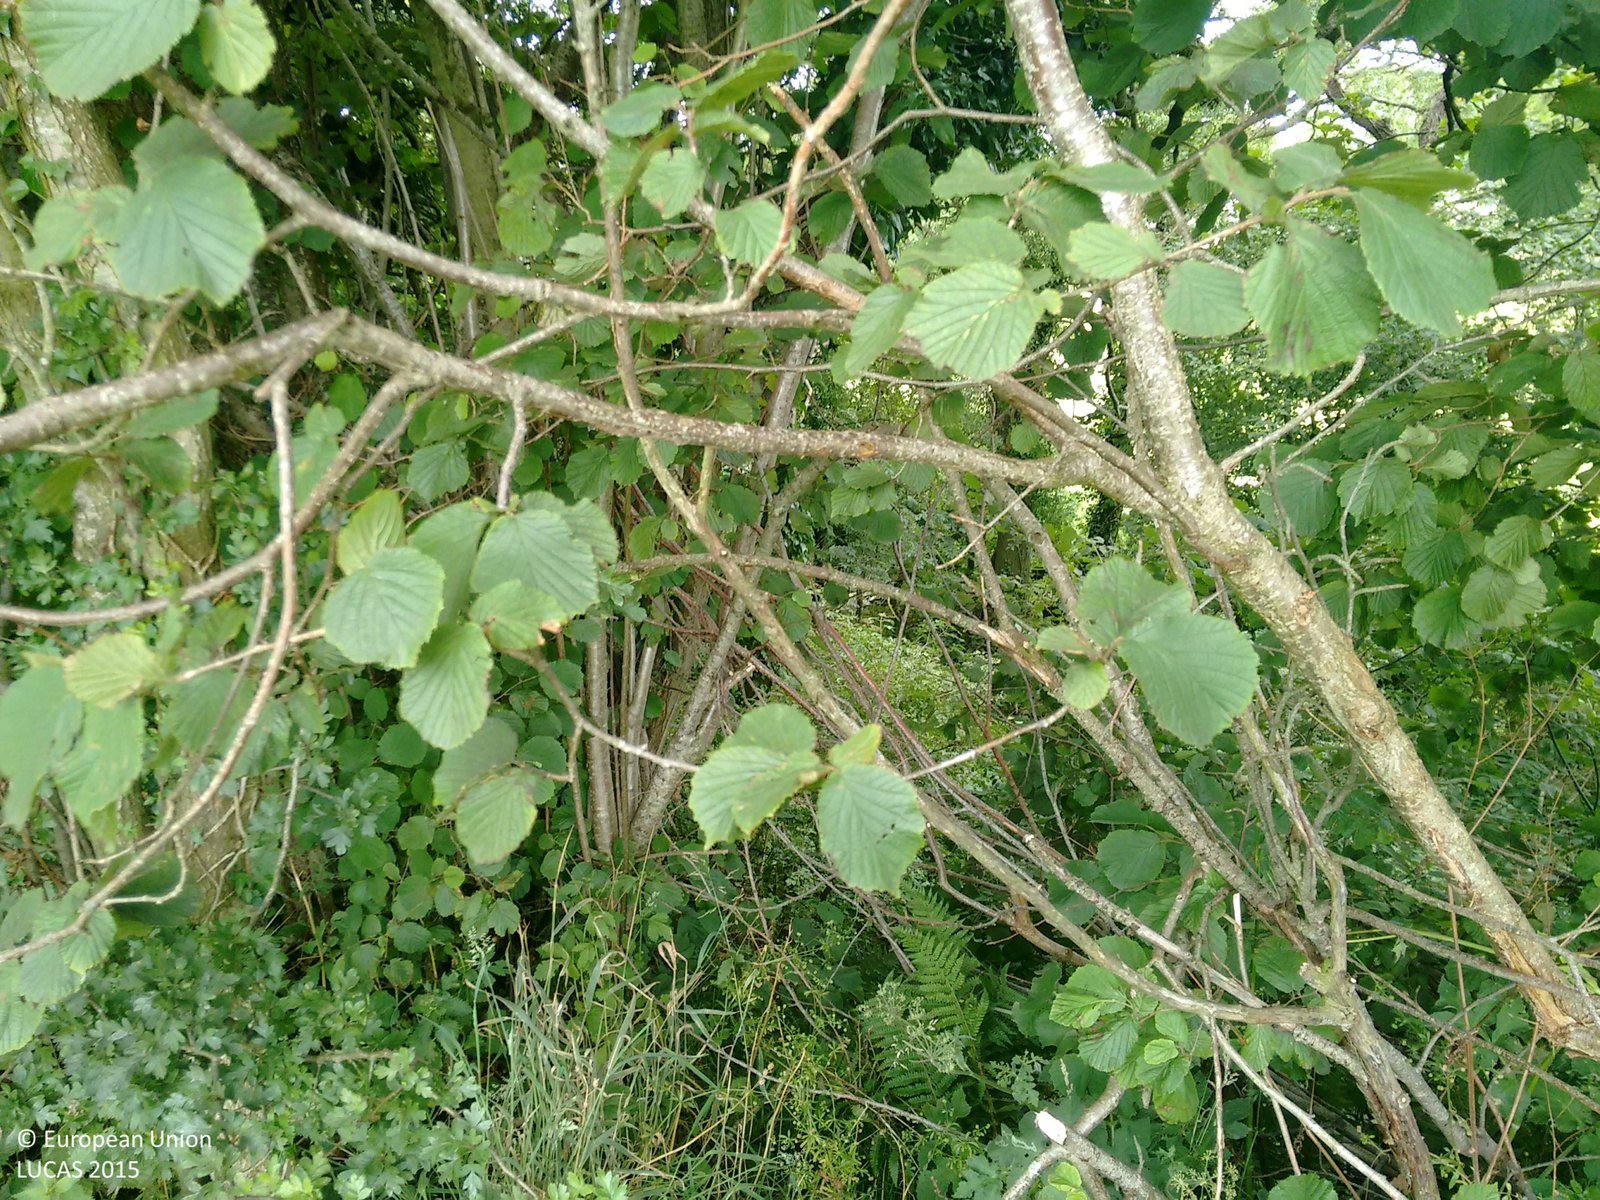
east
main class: Woodland
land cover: Broadleaved woodland
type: mesophytic deciduous forest
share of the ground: > 75 %
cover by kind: broadleaved forest trees 100 %
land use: Abandoned areas
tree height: > 5 m
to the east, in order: Broadleaved woodland; Rivers and streams; Grassland without tree/shrub cover; Lines of trees; Grassland without tree/shrub cover; Tracks; Broadleaved woodland; Grassland without tree/shrub cover
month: August
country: GB
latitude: 54.3147
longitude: -6.6542
